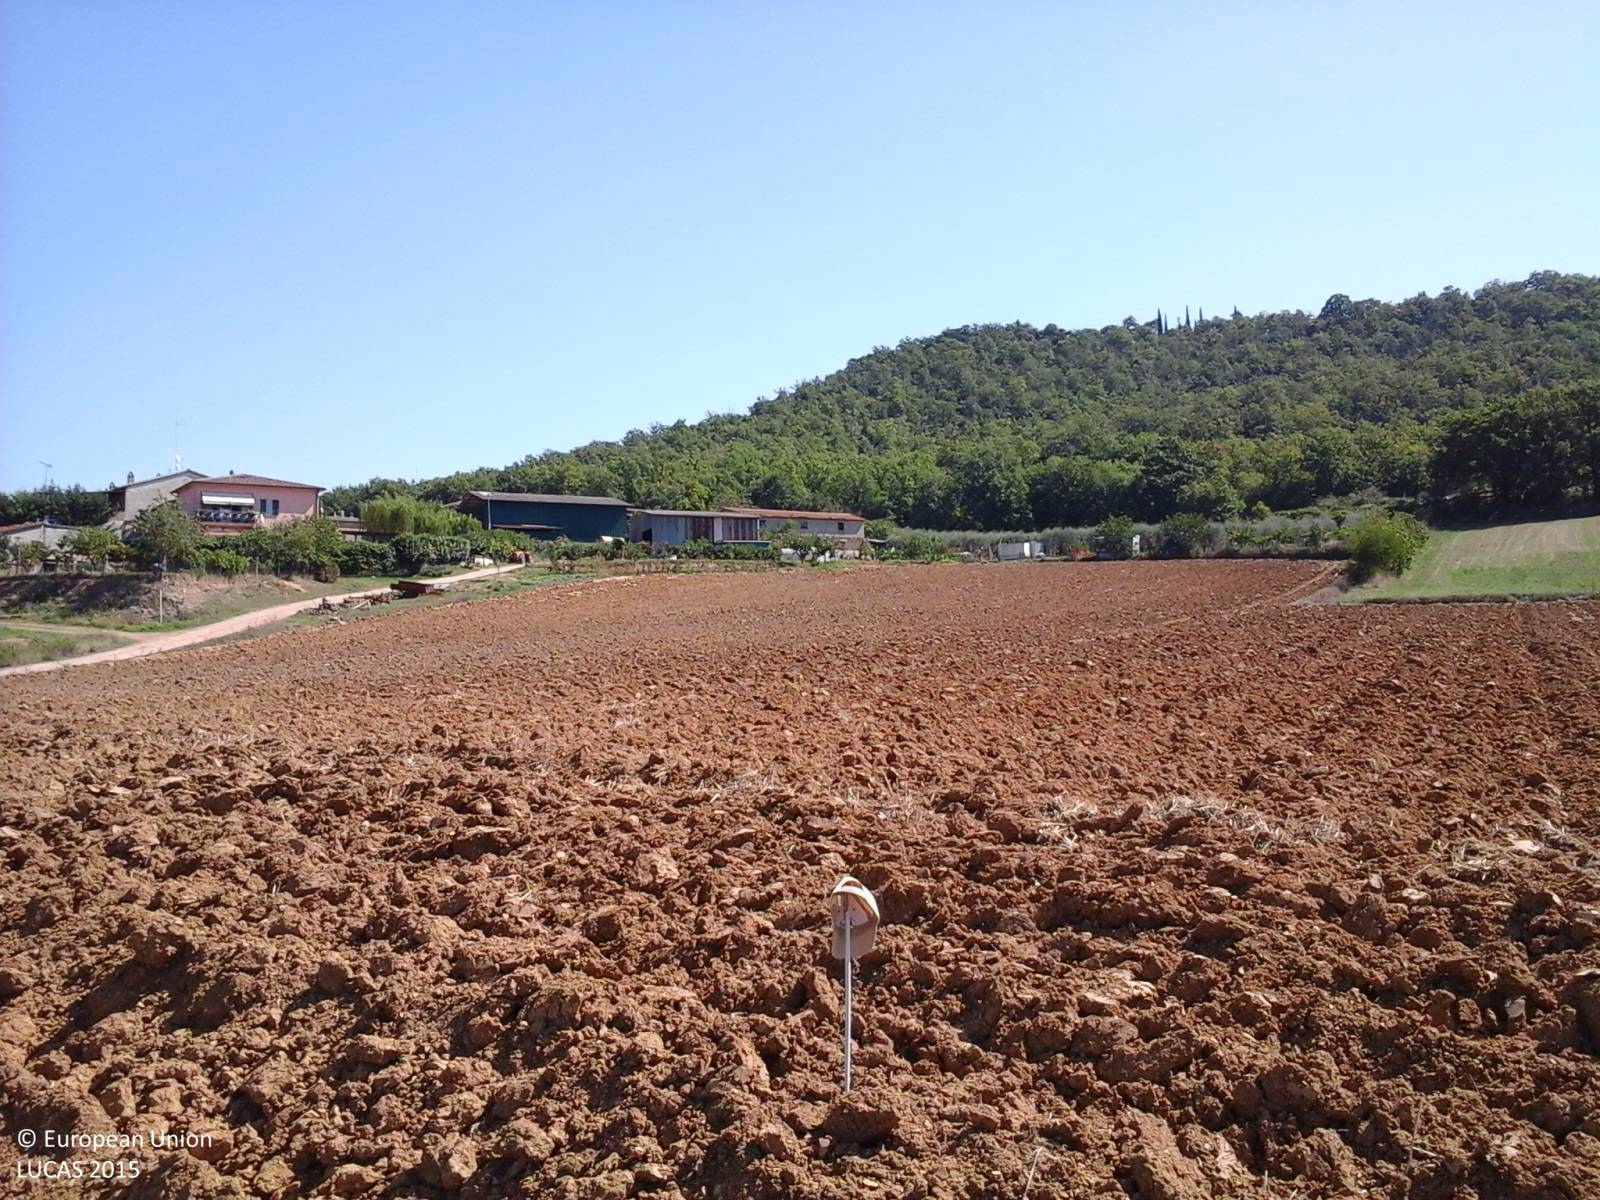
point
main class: Cropland
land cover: Durum wheat
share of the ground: < 10 %
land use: Agriculture (excluding fallow land and kitchen gardens)
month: September
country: IT
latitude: 43.0803
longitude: 12.2657
